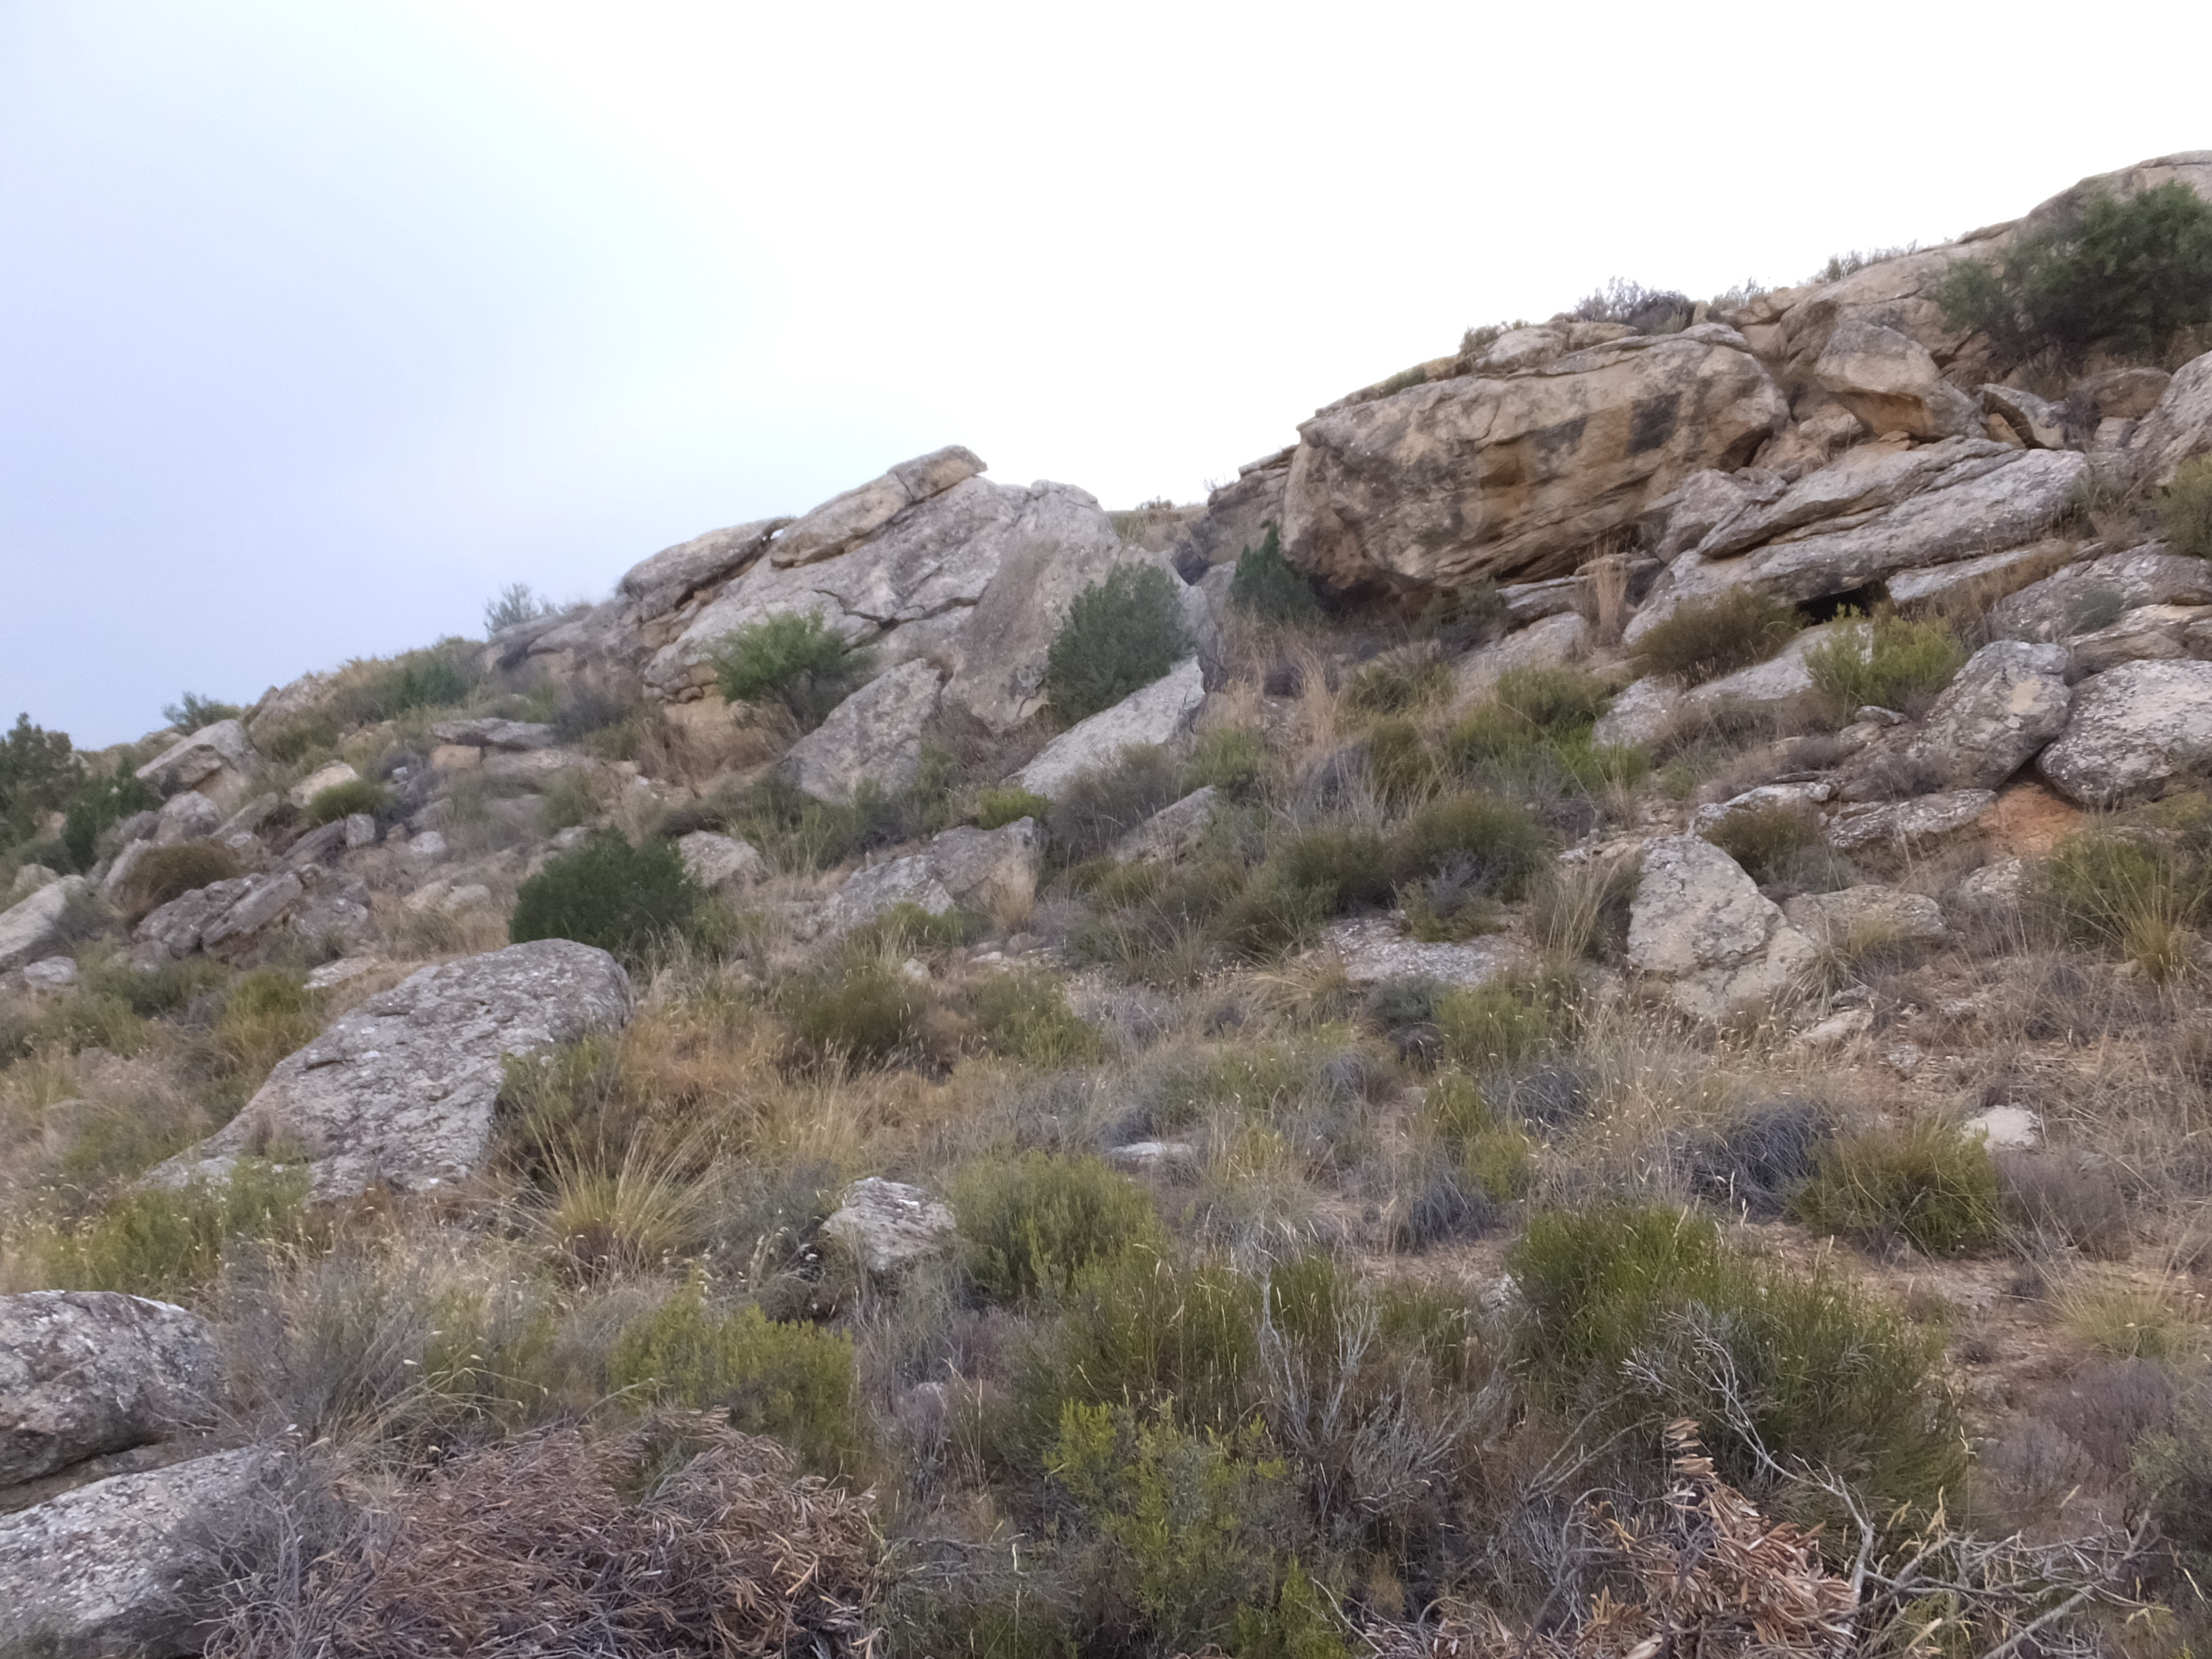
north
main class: Shrubland
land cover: Shrubland without tree cover
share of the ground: > 75 %
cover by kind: shrubs 50 %, herbaceous plants 50 %
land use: Semi-natural and natural areas not in use
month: July
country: ES
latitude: 41.1850
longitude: -0.0863
